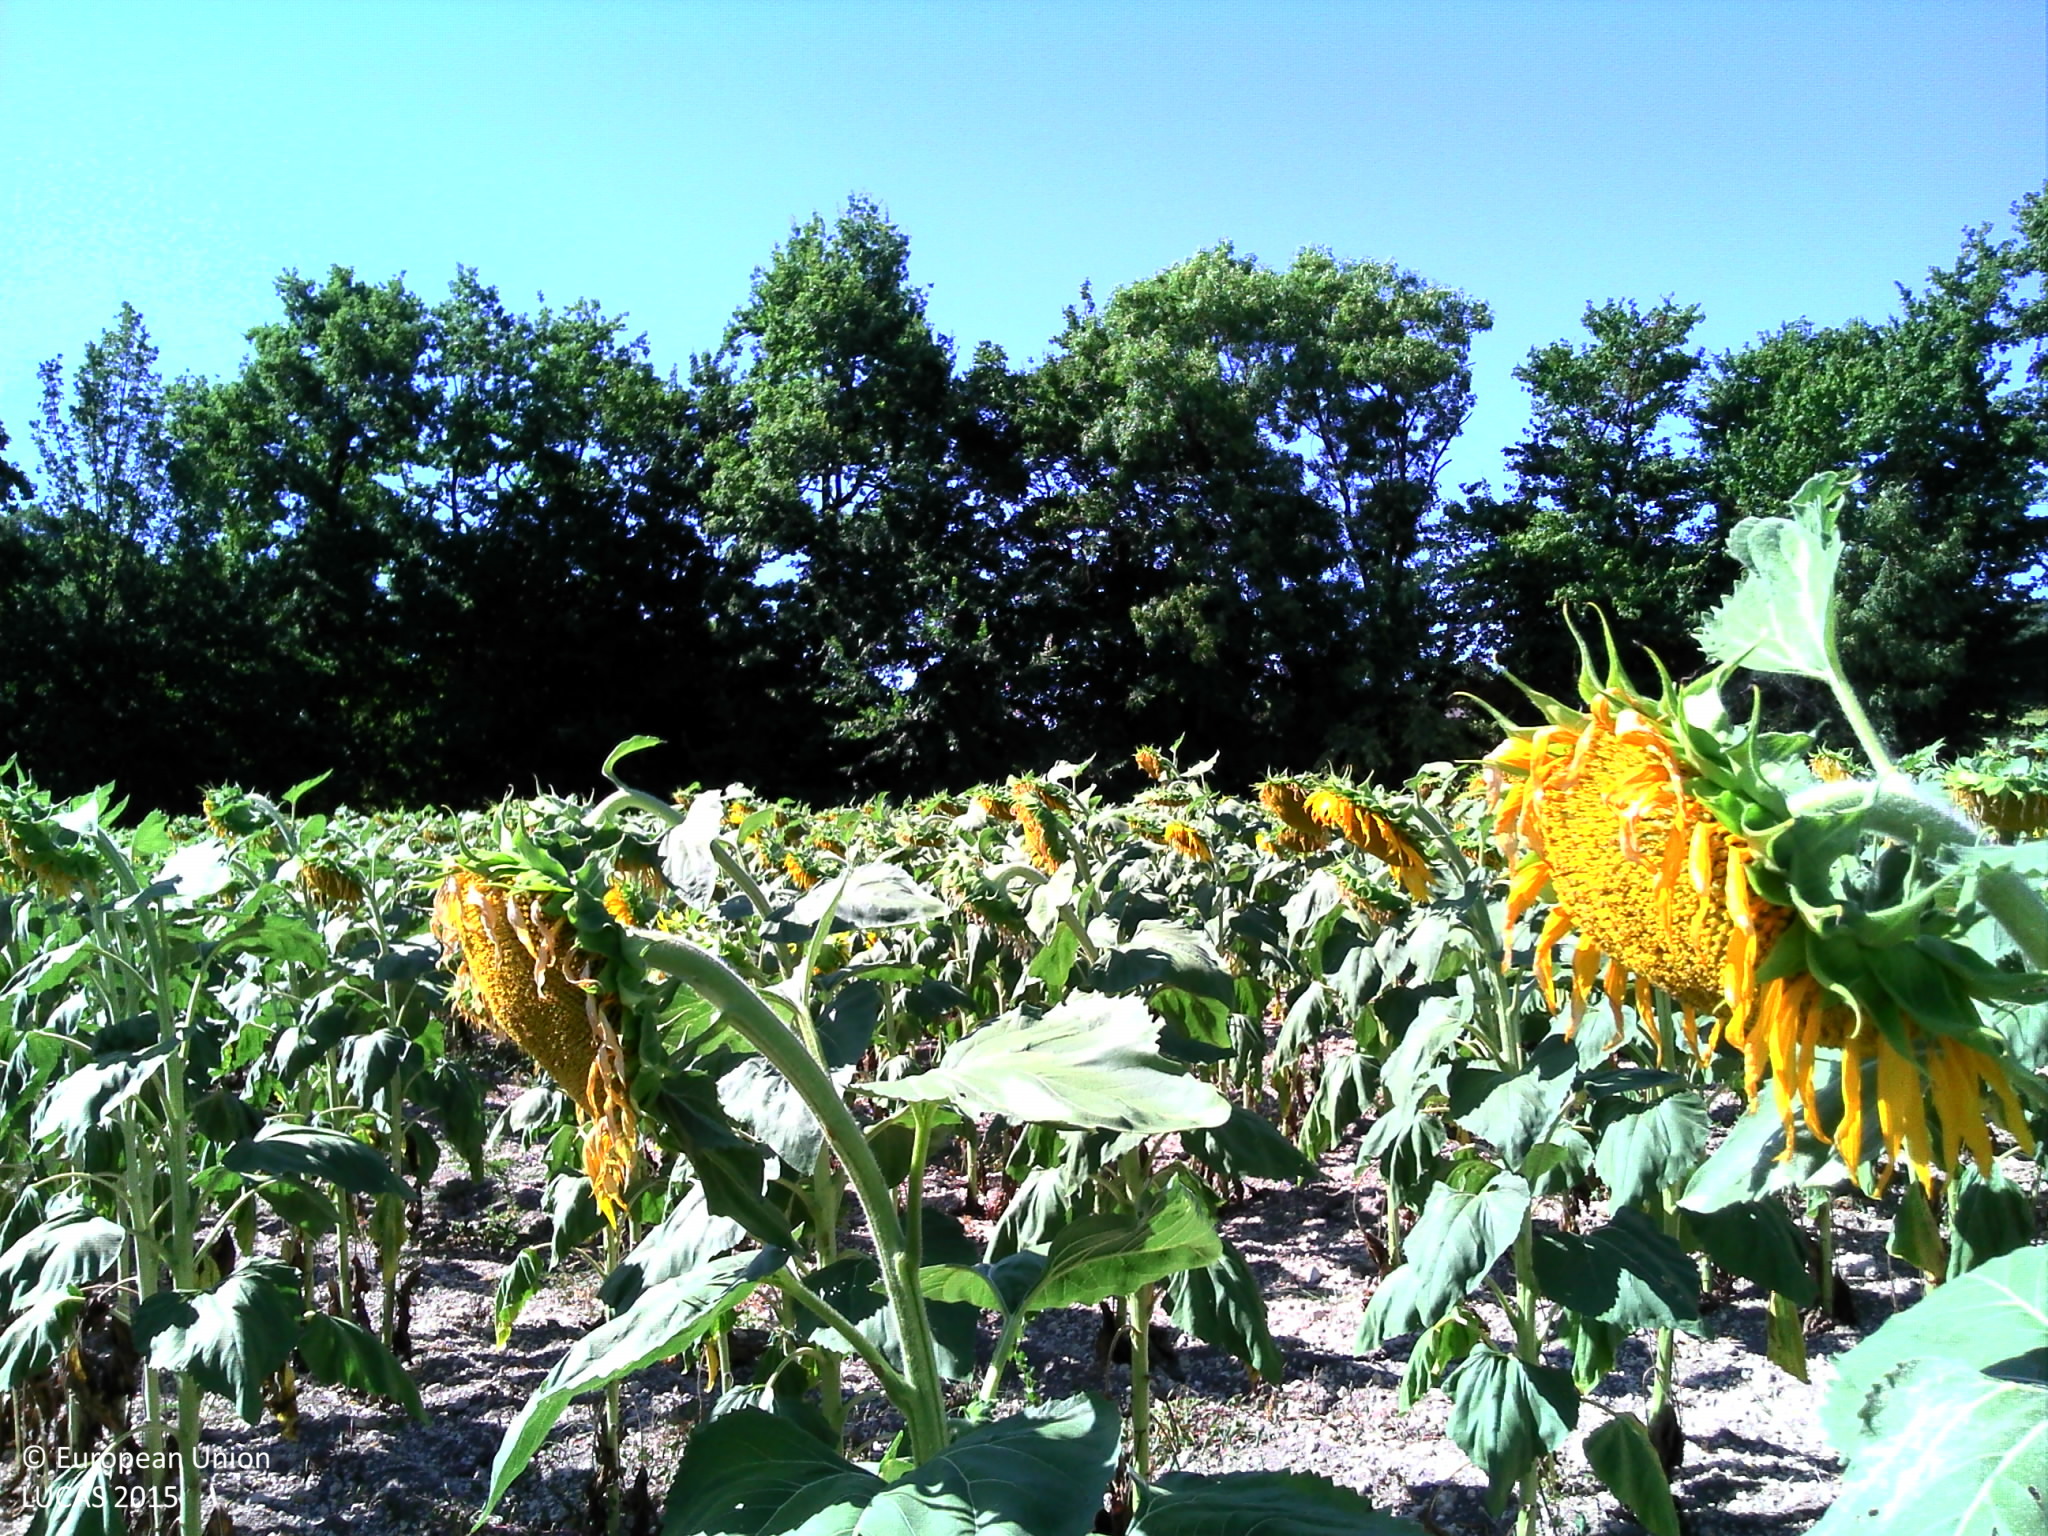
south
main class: Cropland
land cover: Sunflower
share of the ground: 50 - 75 %
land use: Agriculture (excluding fallow land and kitchen gardens)
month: July
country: FR
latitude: 44.7514
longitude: 0.5301
